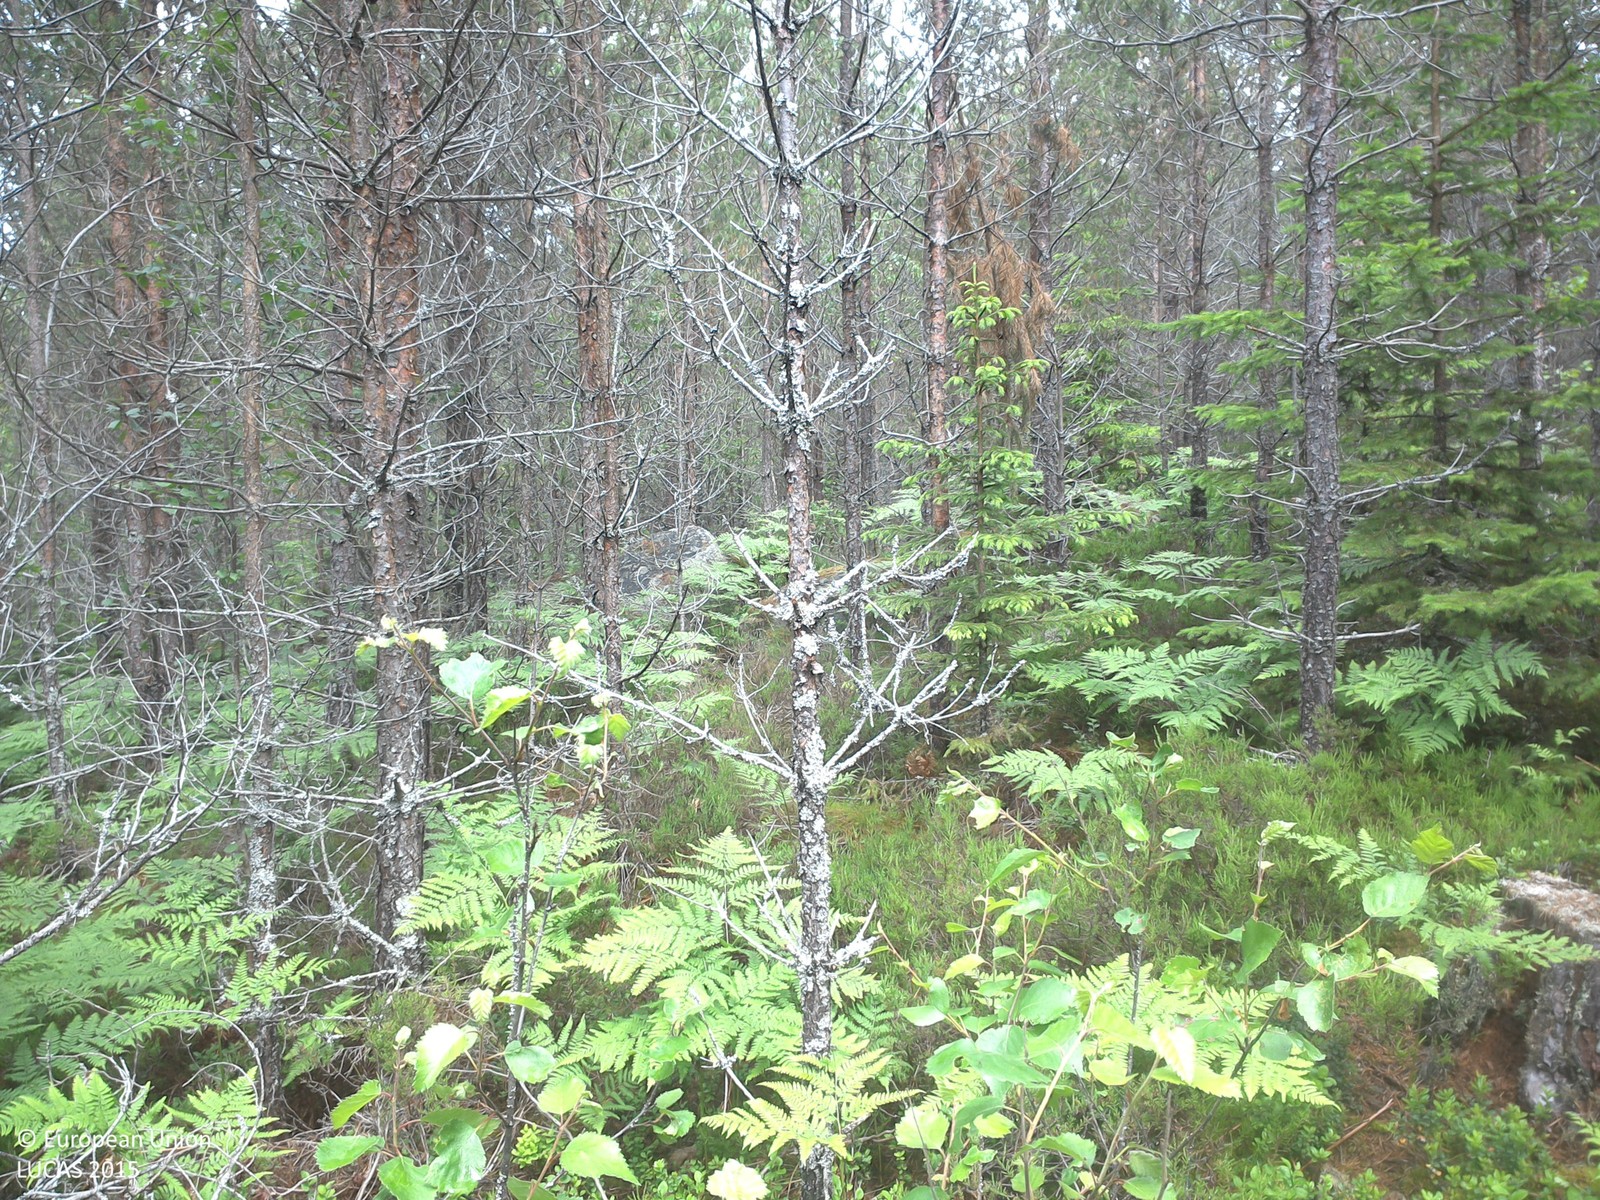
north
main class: Woodland
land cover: Pine dominated coniferous woodland
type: boreal forest
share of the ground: 50 - 75 %
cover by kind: coniferous forest trees 70 %, lichens and mosses 25 %, herbaceous plants 5 %
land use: Forestry
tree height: > 5 m
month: June
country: SE
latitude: 58.1217
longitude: 15.5807
